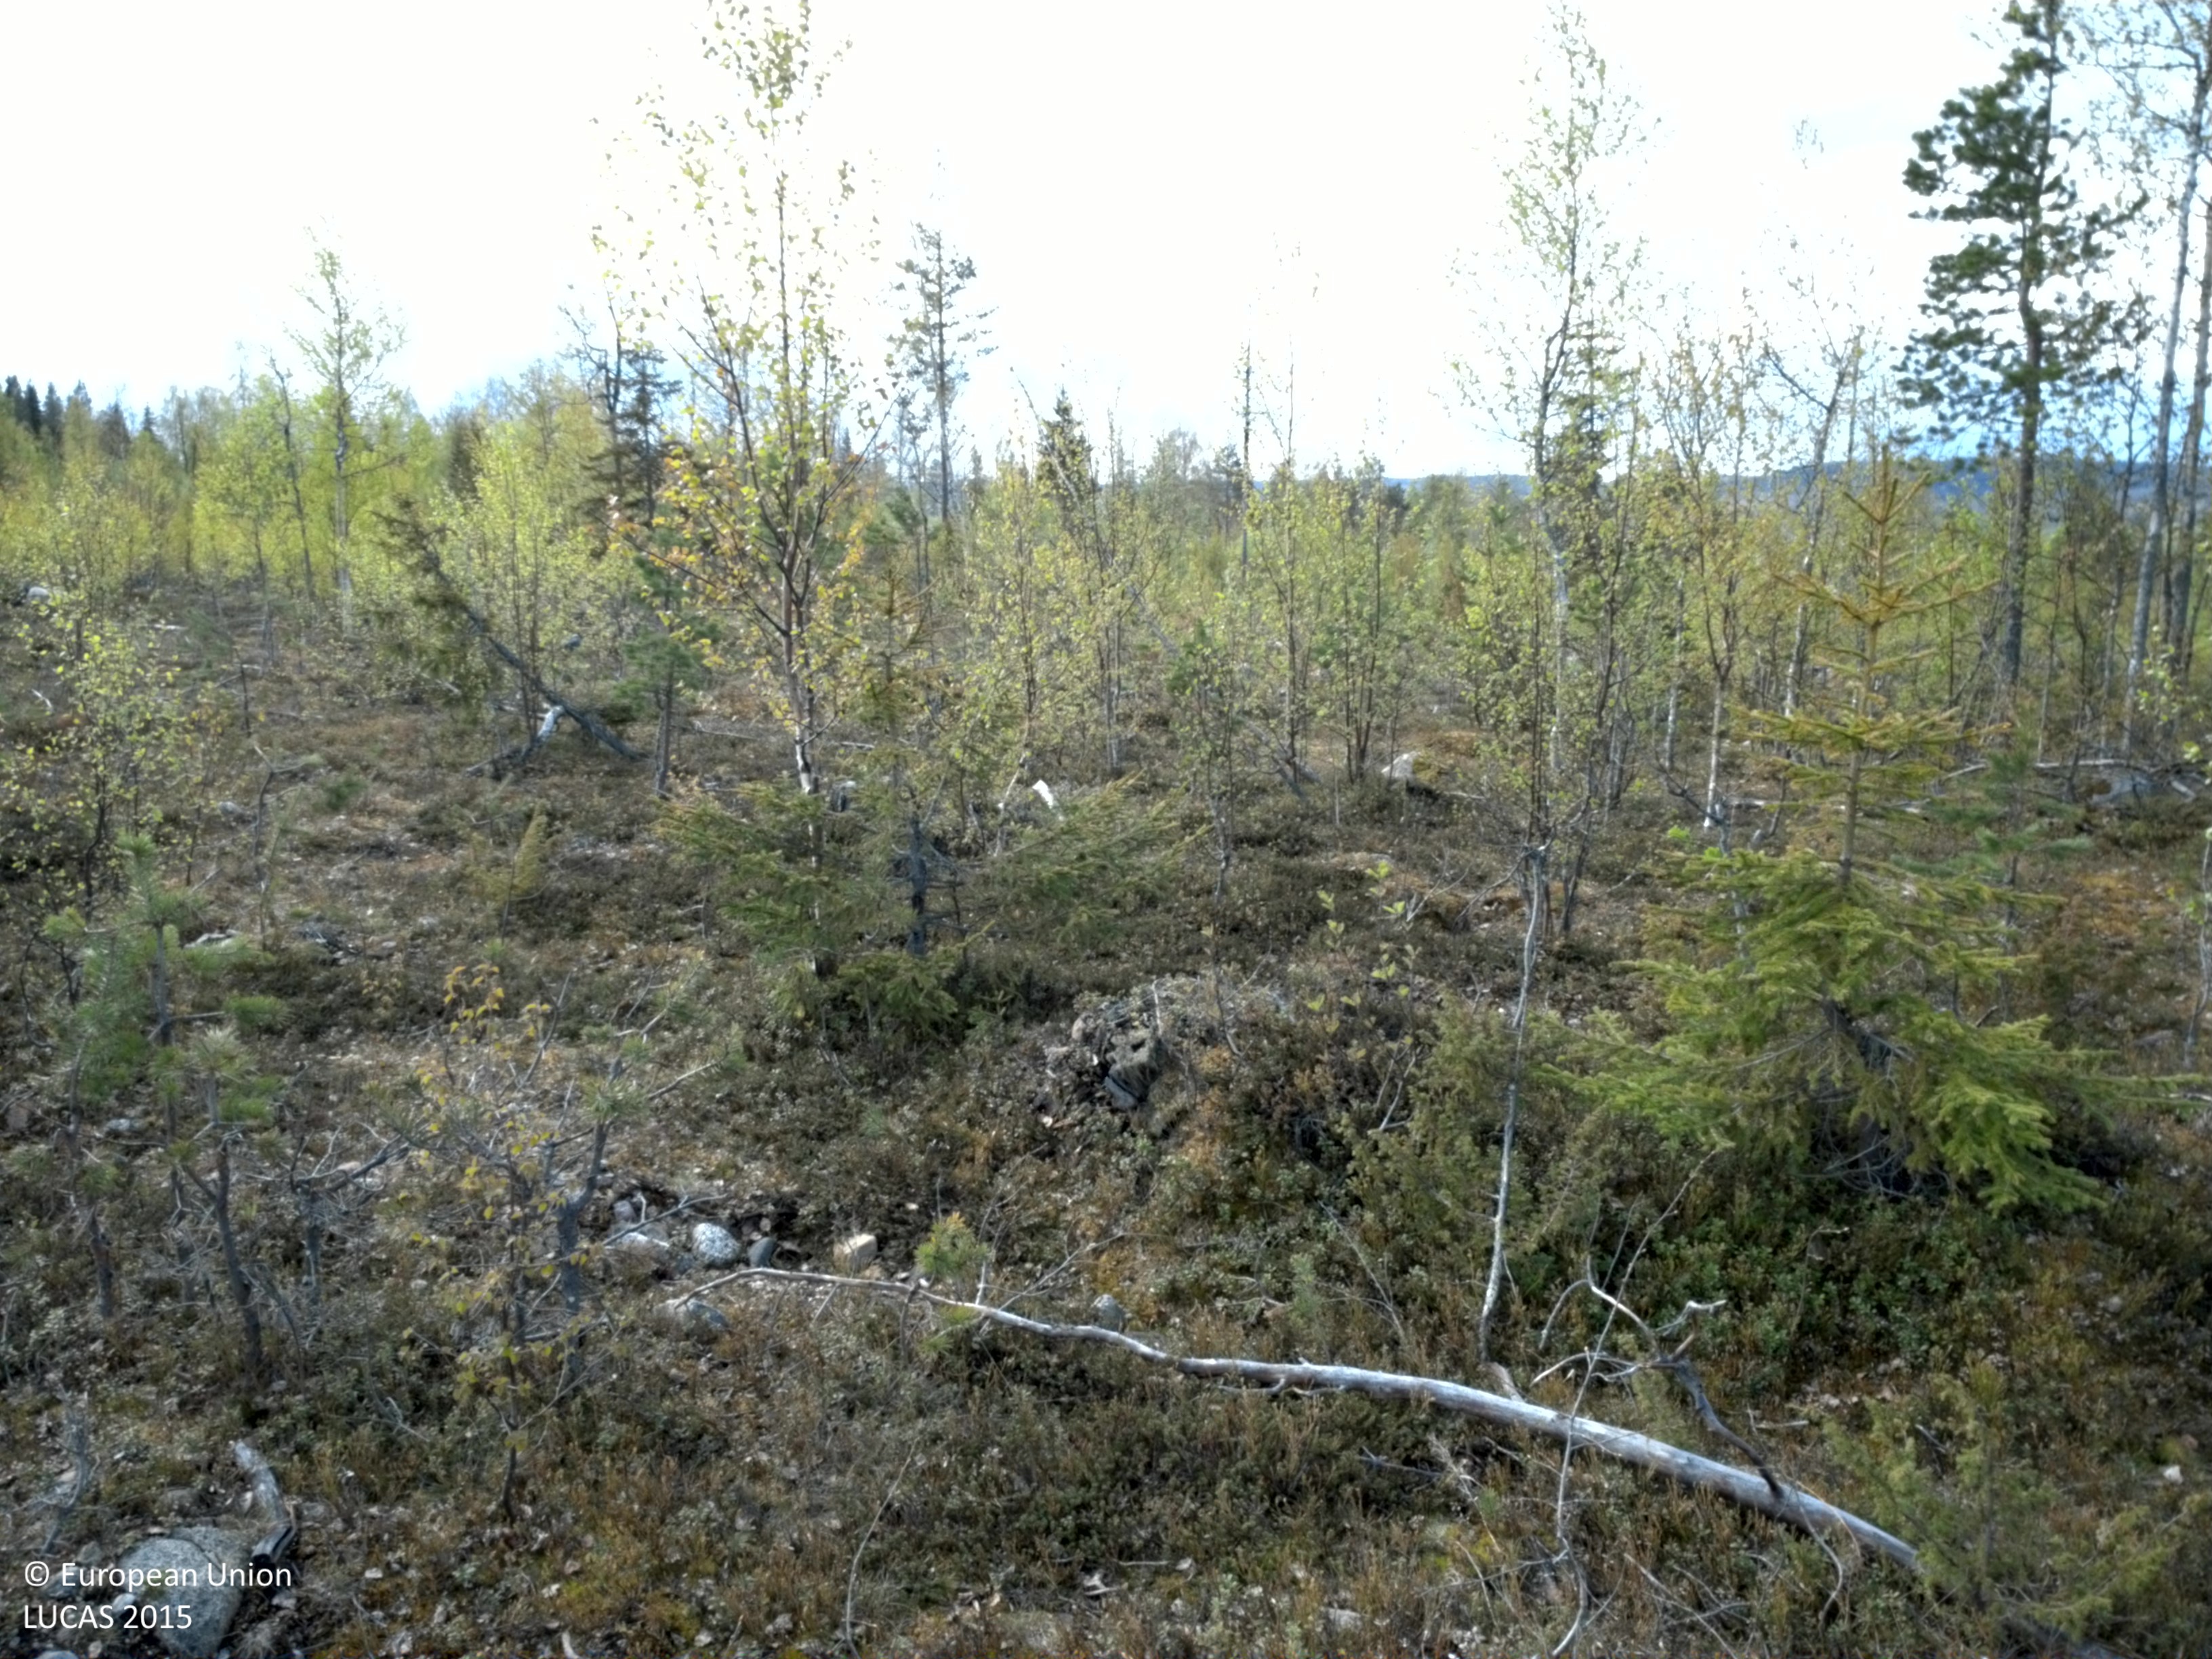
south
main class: Woodland
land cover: Pine dominated mixed woodland
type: boreal forest
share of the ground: 10 - 25 %
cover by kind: shrubs 75 %, broadleaved forest trees 15 %, coniferous forest trees 10 %
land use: Forestry
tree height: < 5 m
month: June
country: SE
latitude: 66.4240
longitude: 23.3594
